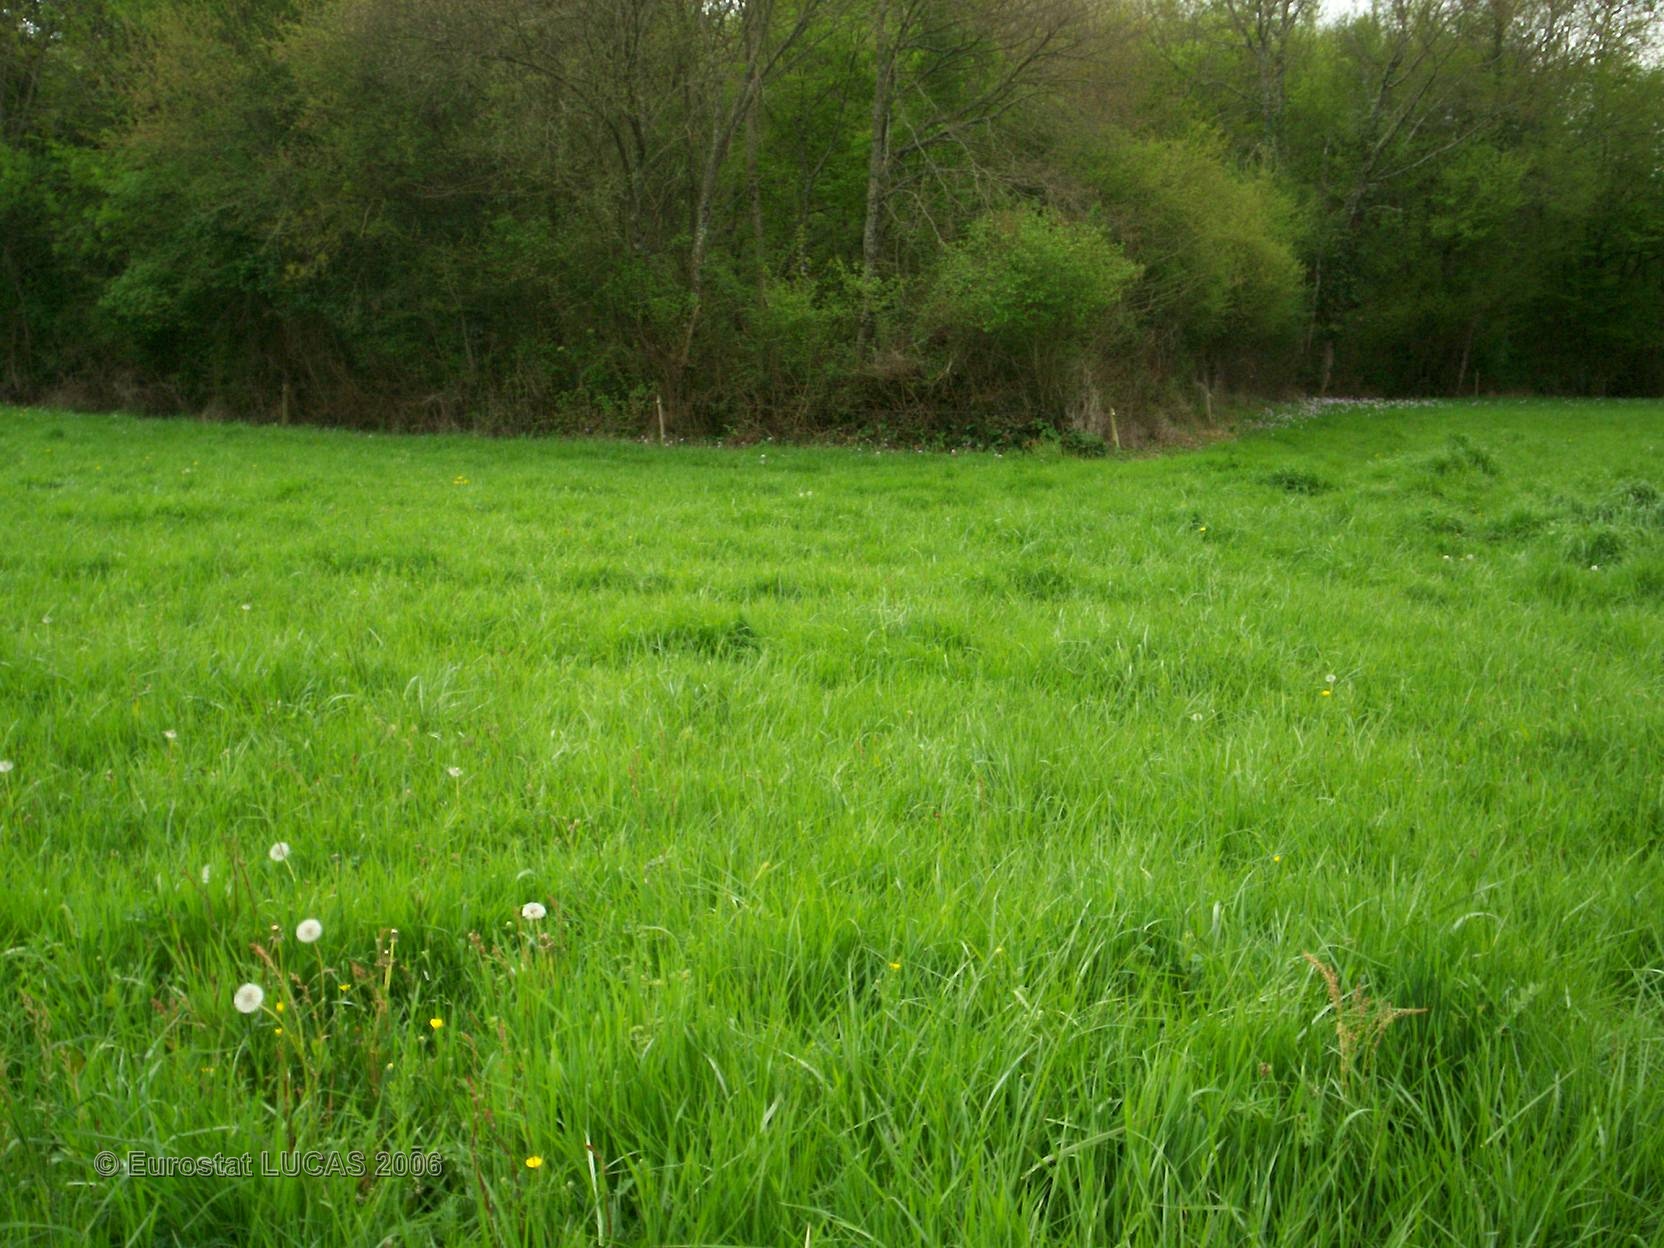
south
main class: Grassland
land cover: Grassland without tree/shrub cover
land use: Agriculture (excluding fallow land and kitchen gardens)
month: April
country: FR
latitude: 43.7223
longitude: 0.2007
